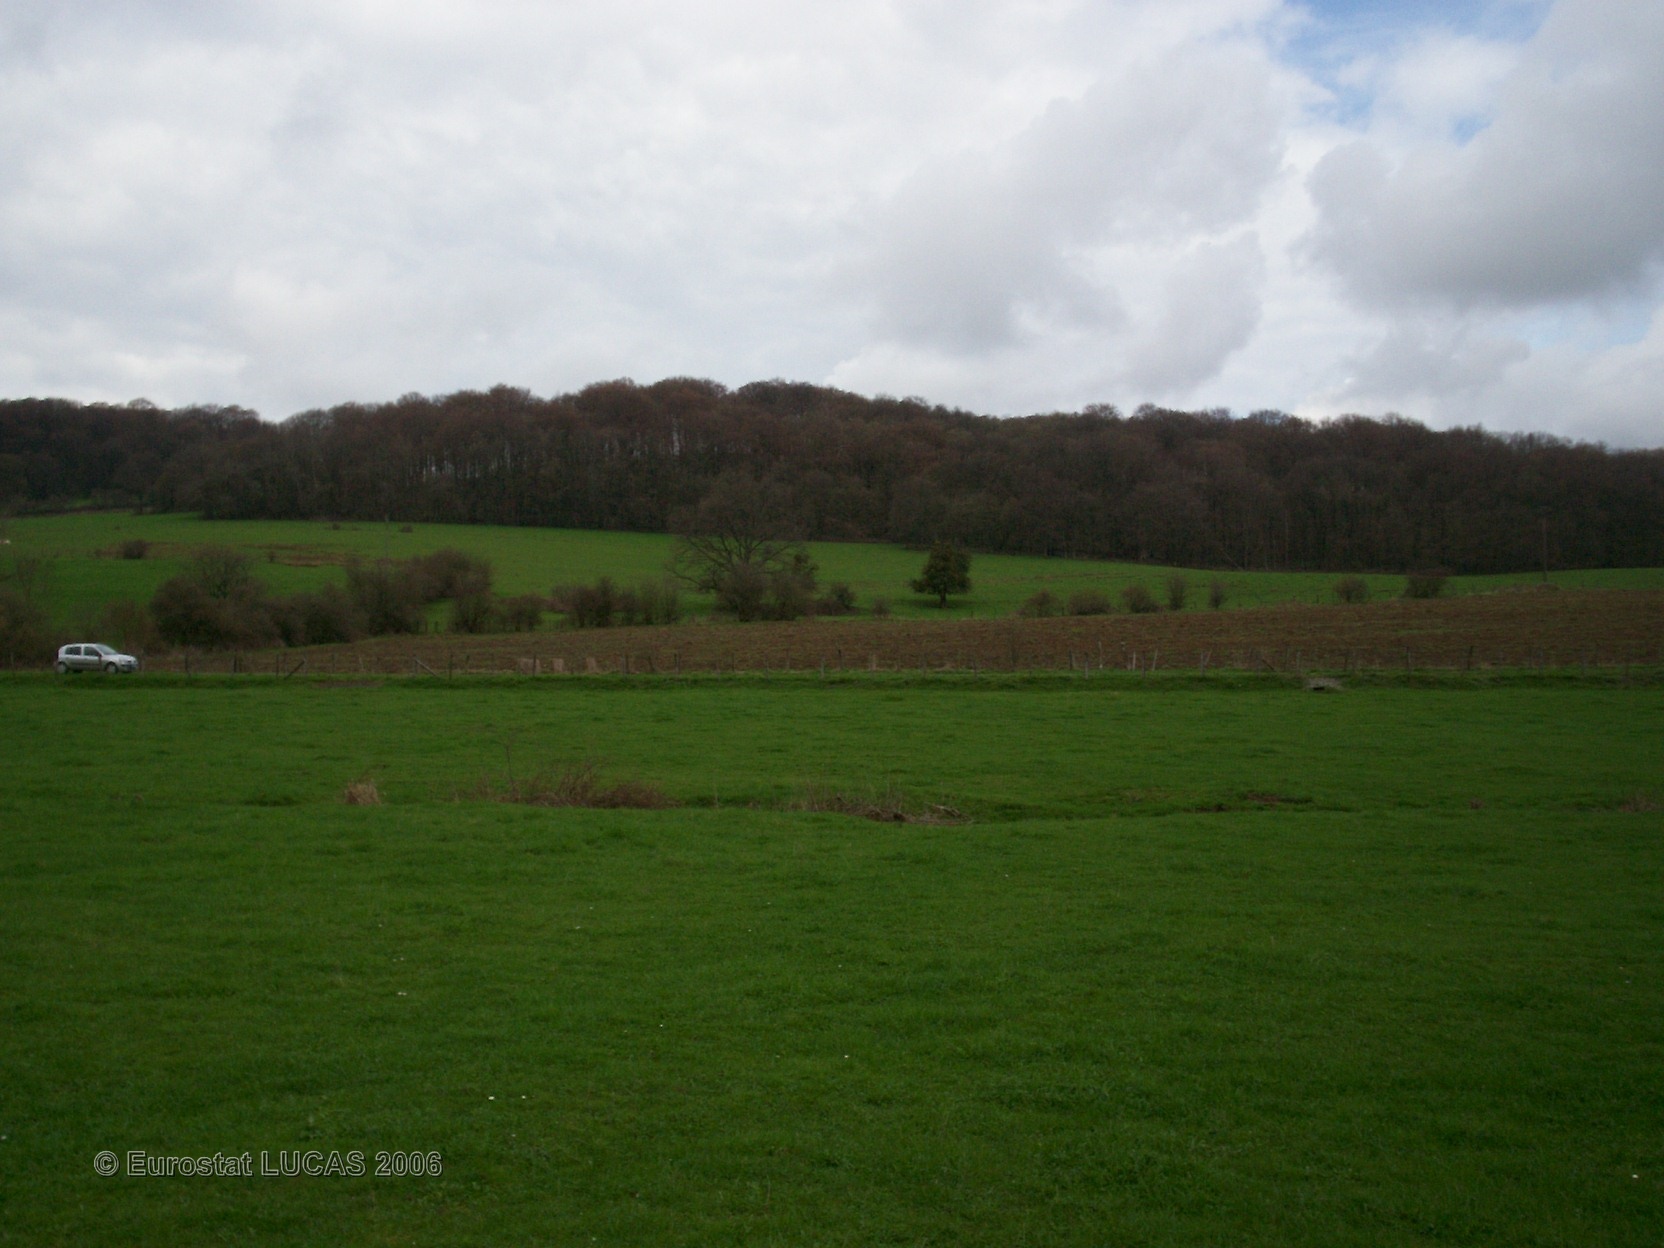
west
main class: Grassland
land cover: Grassland with sparse tree/shrub cover
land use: Agriculture (excluding fallow land and kitchen gardens)
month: April
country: FR
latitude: 47.5419
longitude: 6.6403
